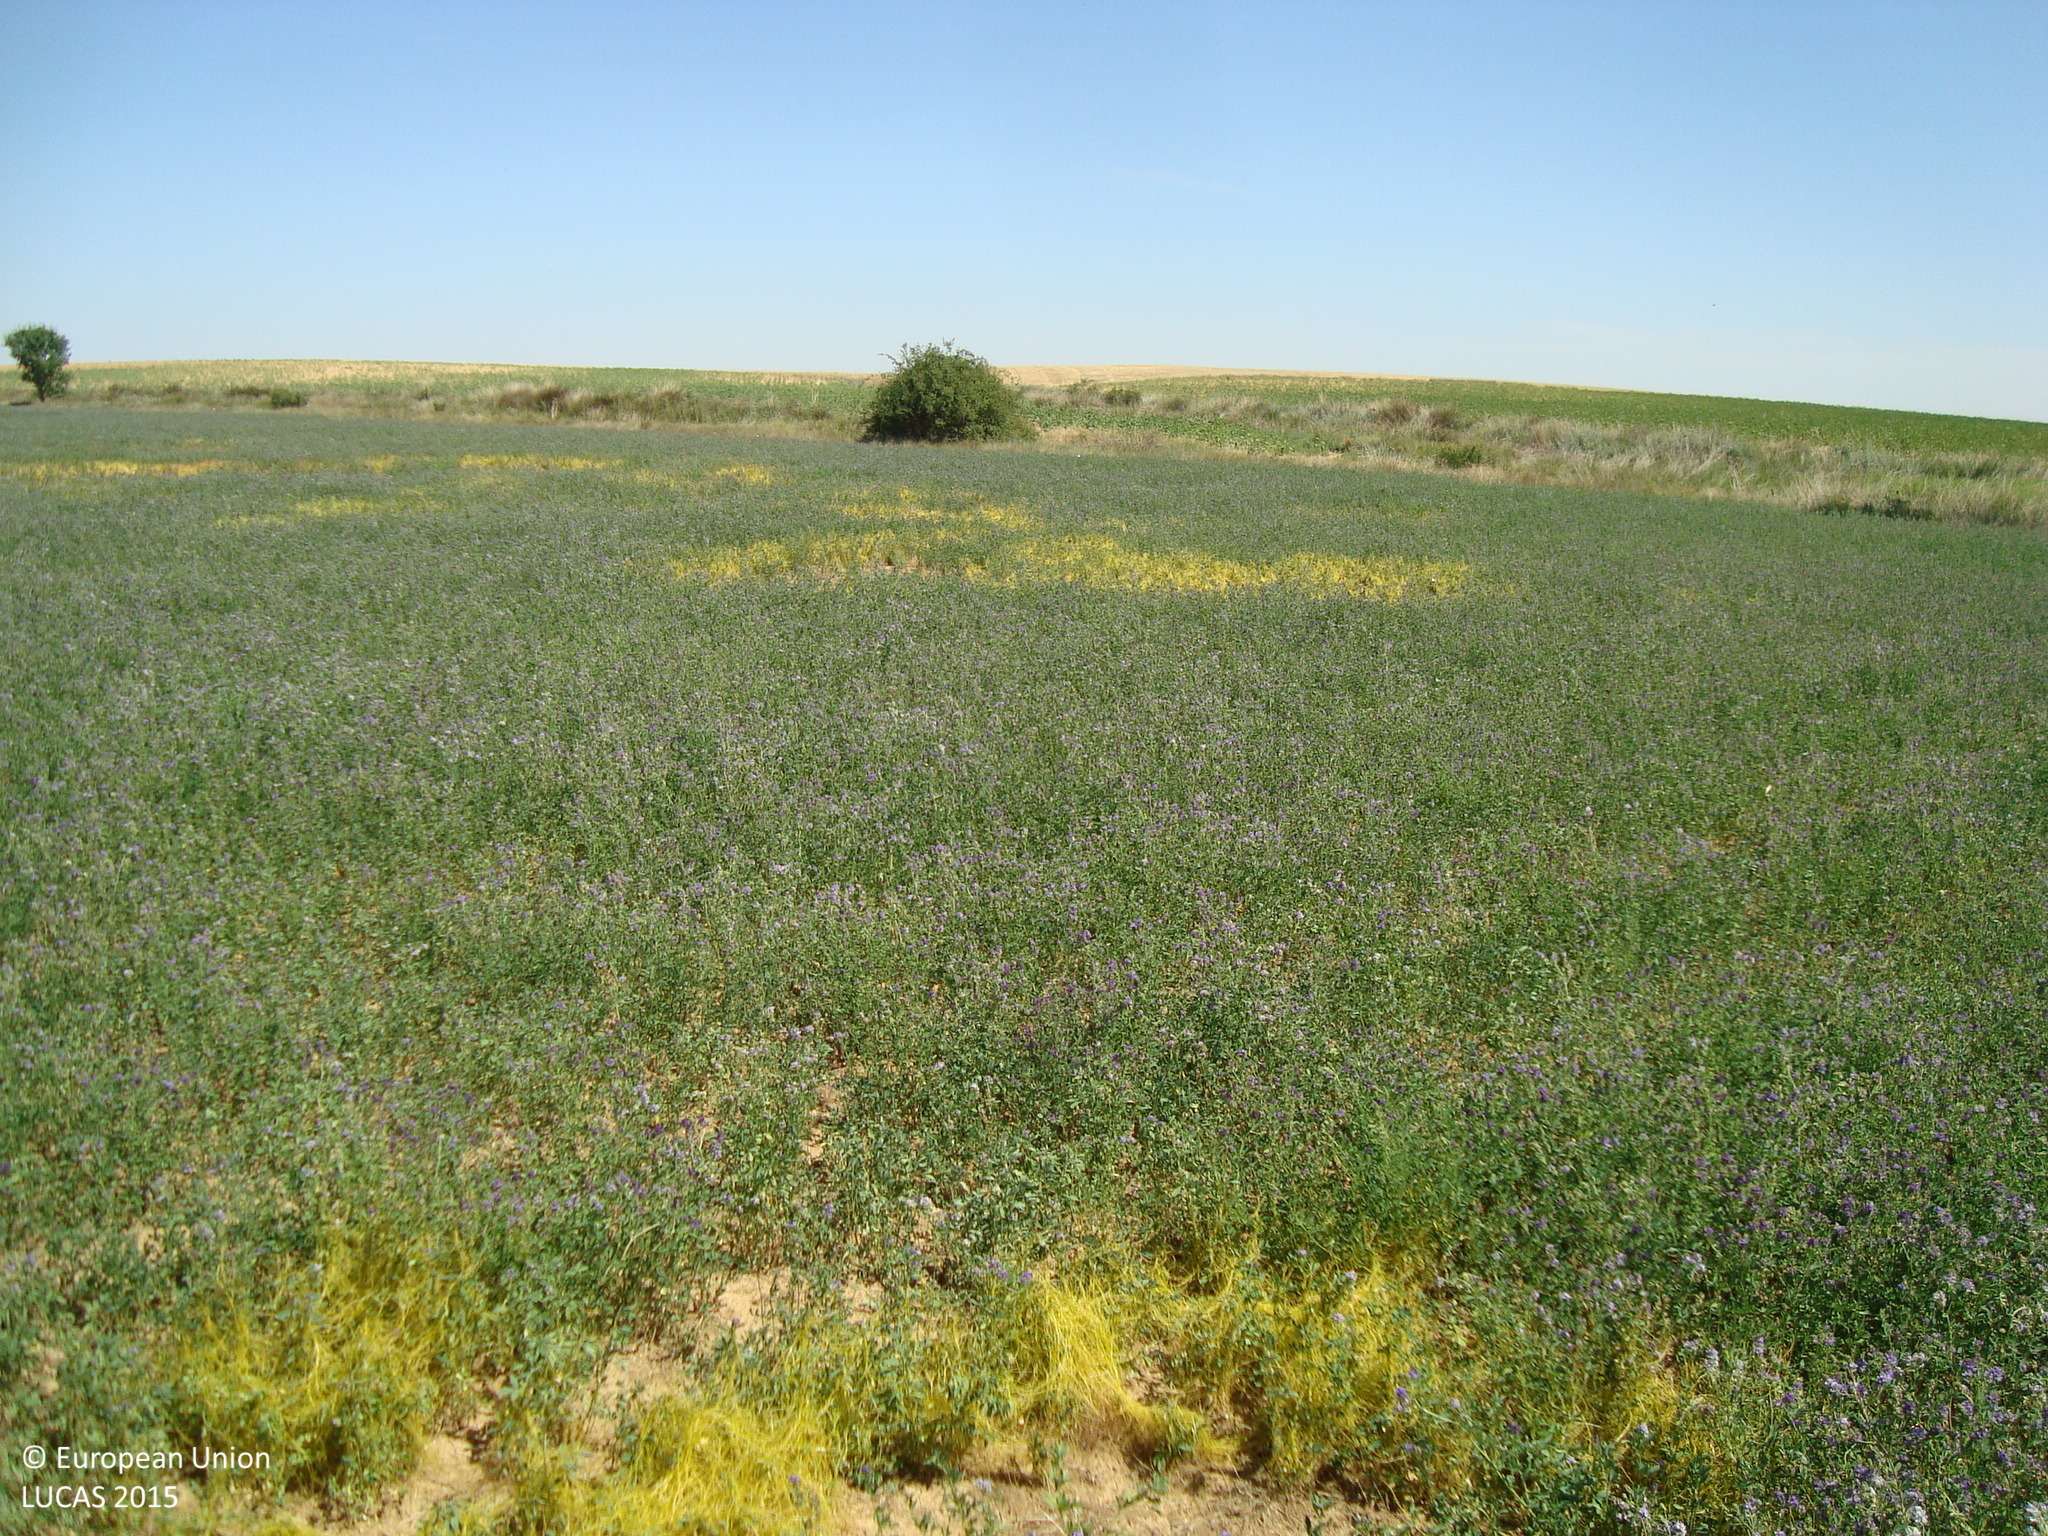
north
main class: Cropland
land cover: Lucerne
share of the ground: > 75 %
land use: Agriculture (excluding fallow land and kitchen gardens)
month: July
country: ES
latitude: 42.0930
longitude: -4.7898
